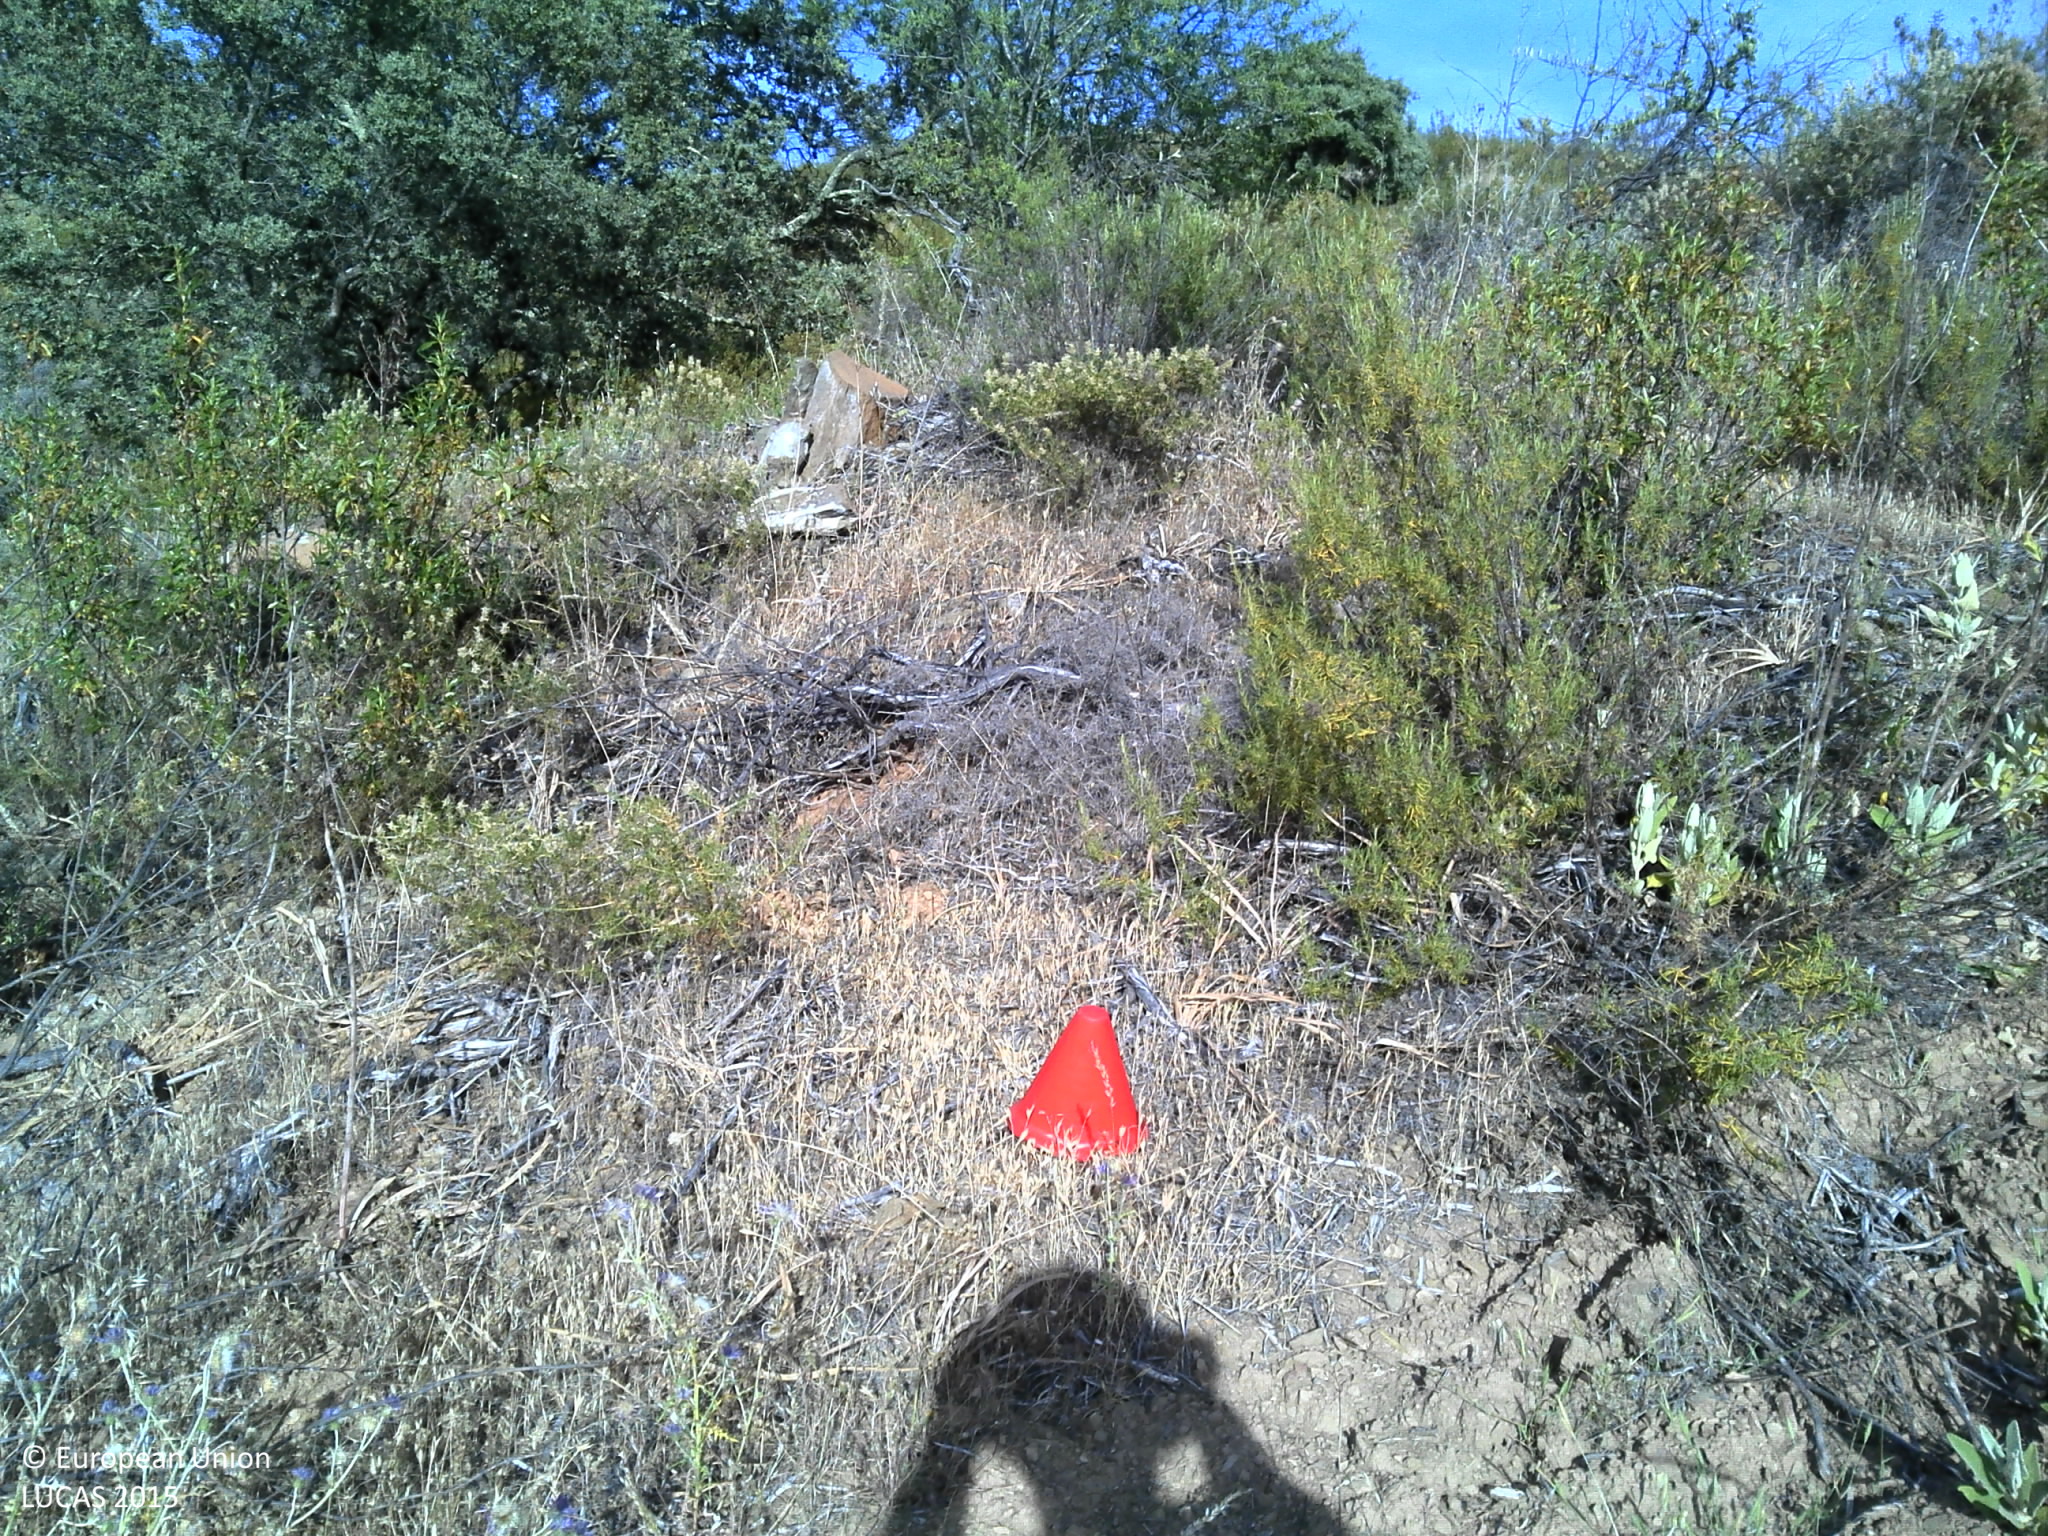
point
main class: Shrubland
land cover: Shrubland with sparse tree cover
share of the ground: 50 - 75 %
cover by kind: shrubs 75 %, unconsolidated bare surface 20 %, broadleaved forest trees 5 %
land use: Abandoned areas
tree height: > 5 m
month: May
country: PT
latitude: 37.2987
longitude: -7.4794
